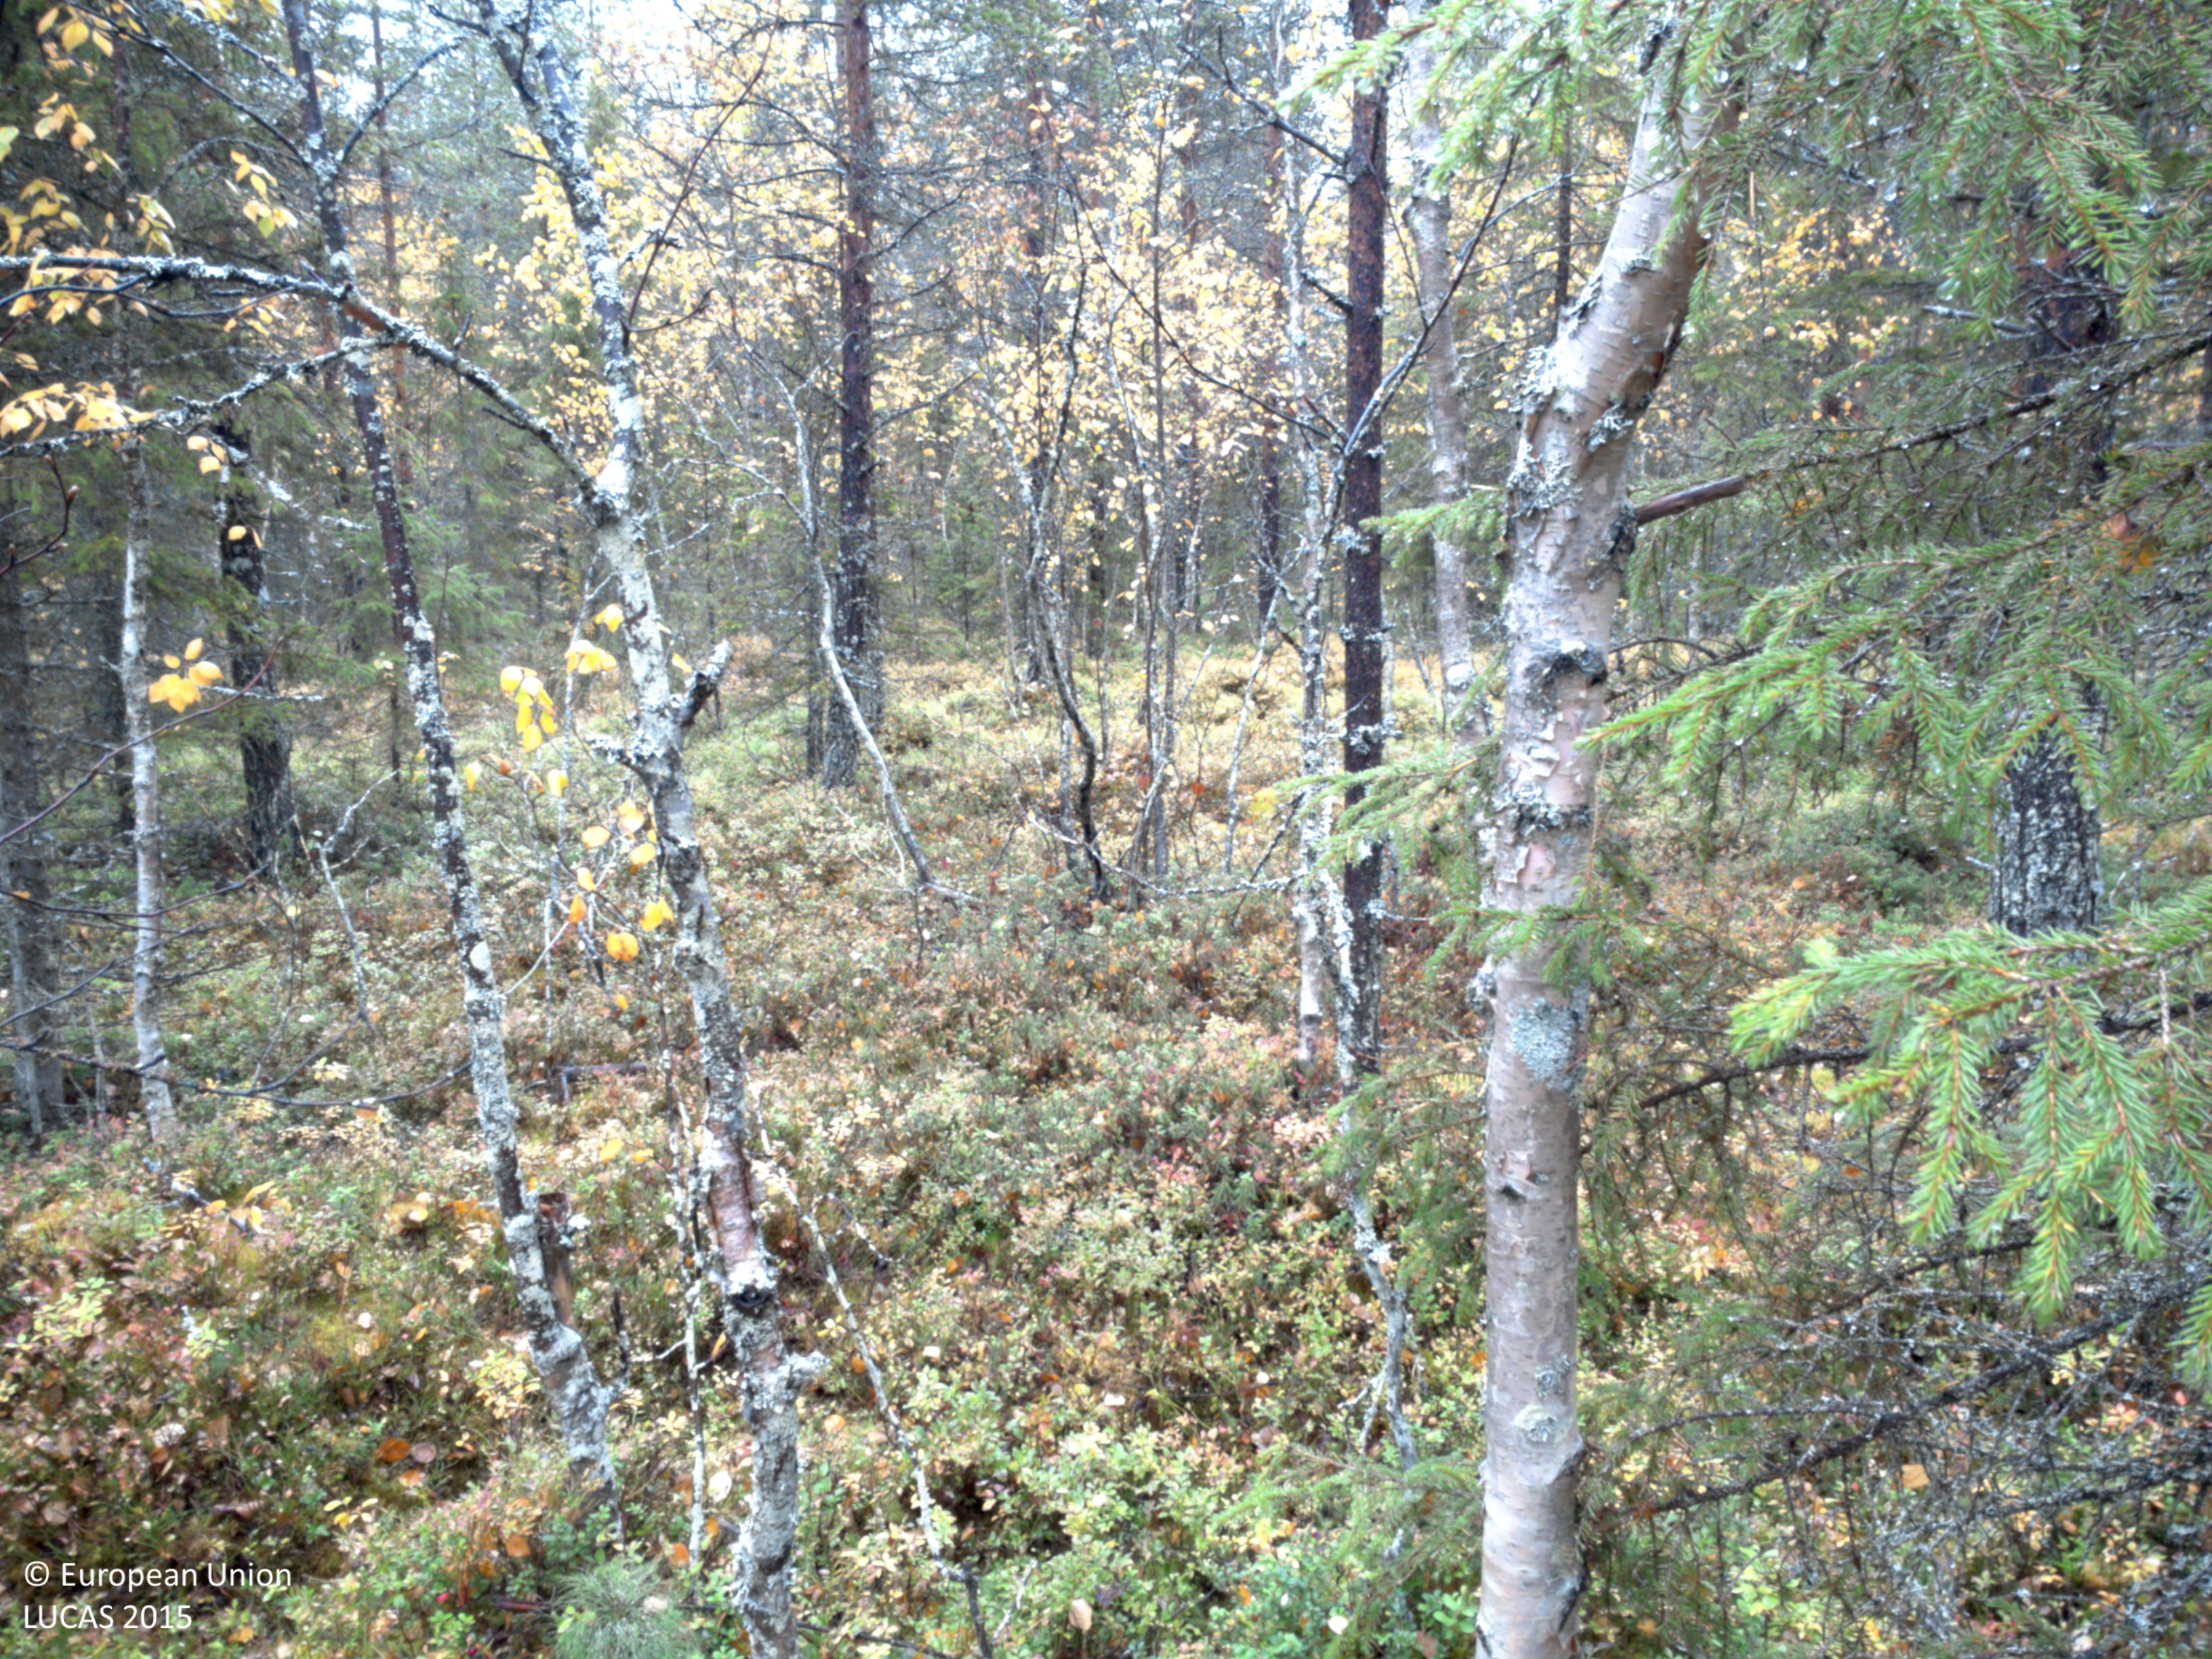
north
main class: Woodland
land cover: Pine dominated mixed woodland
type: mire and swamp forests
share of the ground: 50 - 75 %
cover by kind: shrubs 40 %, coniferous forest trees 35 %, broadleaved forest trees 15 %, lichens and mosses 10 %
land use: Forestry
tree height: > 5 m
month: September
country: SE
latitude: 64.9337
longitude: 19.1686
